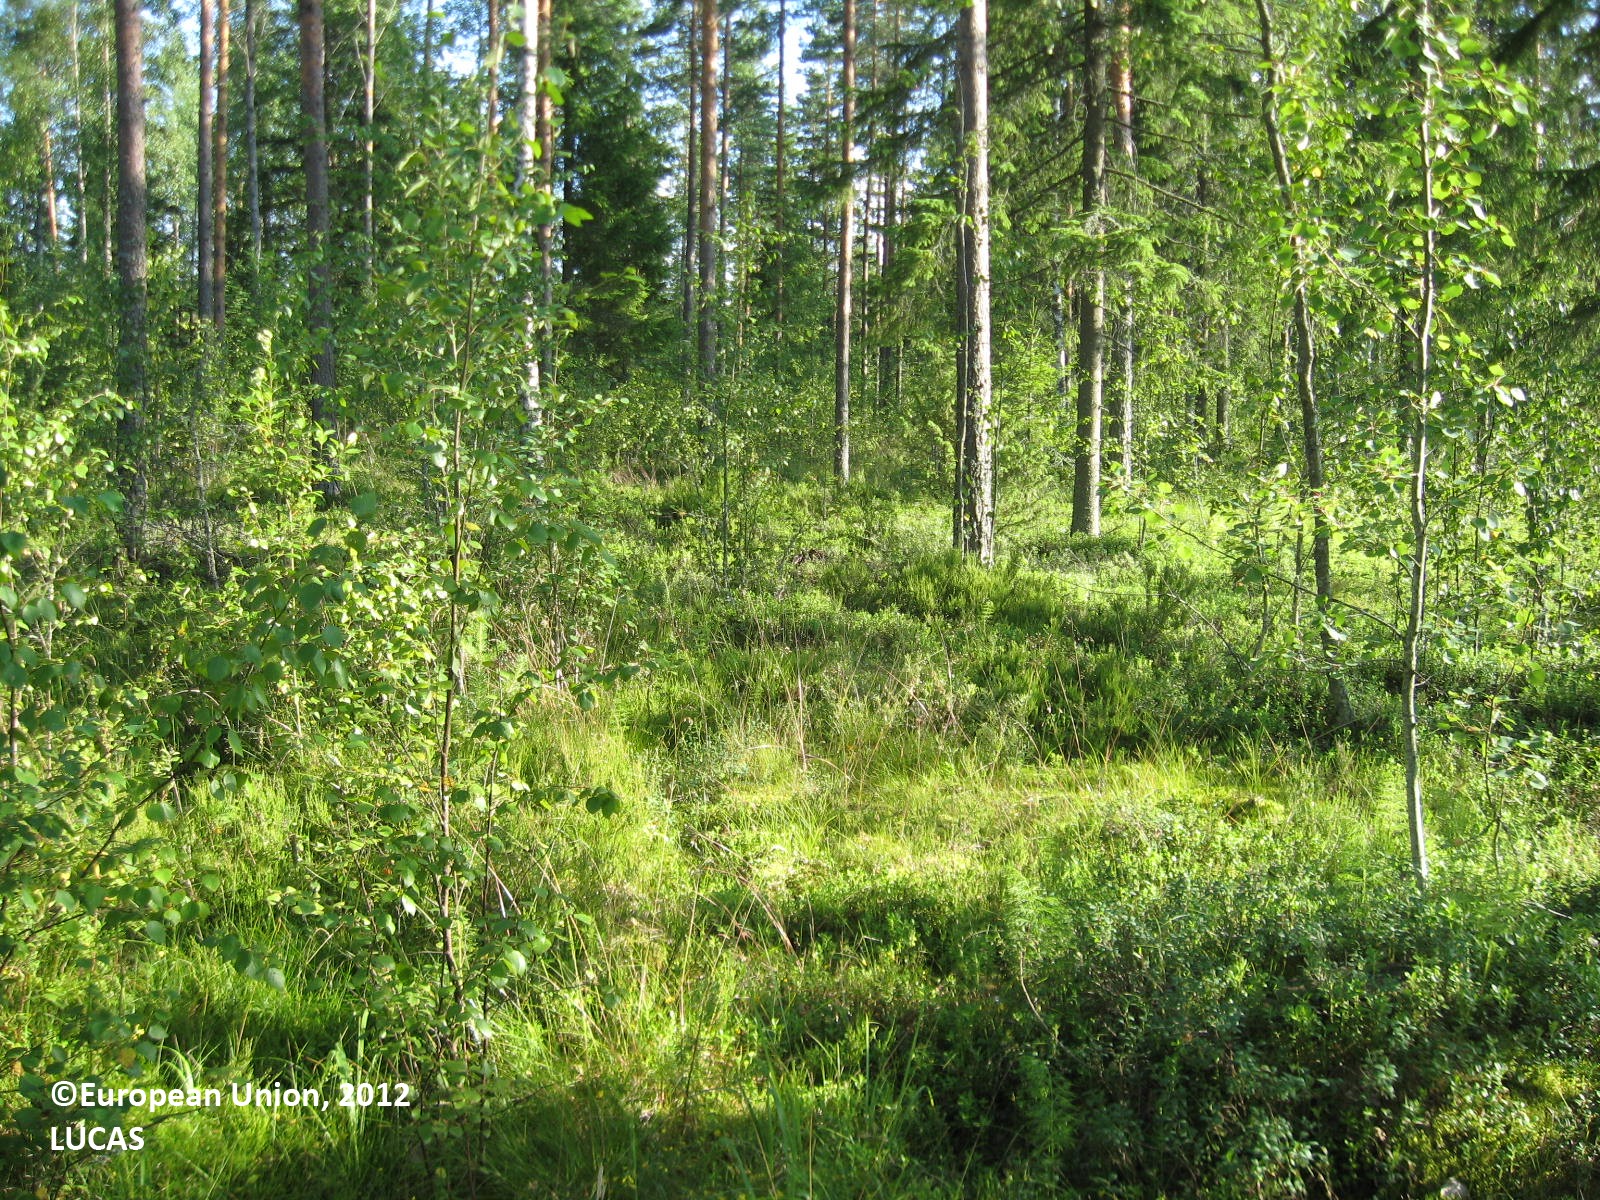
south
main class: Woodland
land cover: Pine dominated mixed woodland
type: boreal forest
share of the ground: > 75 %
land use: Forestry
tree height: > 5 m
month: July
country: FI
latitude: 61.9150
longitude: 22.6098
